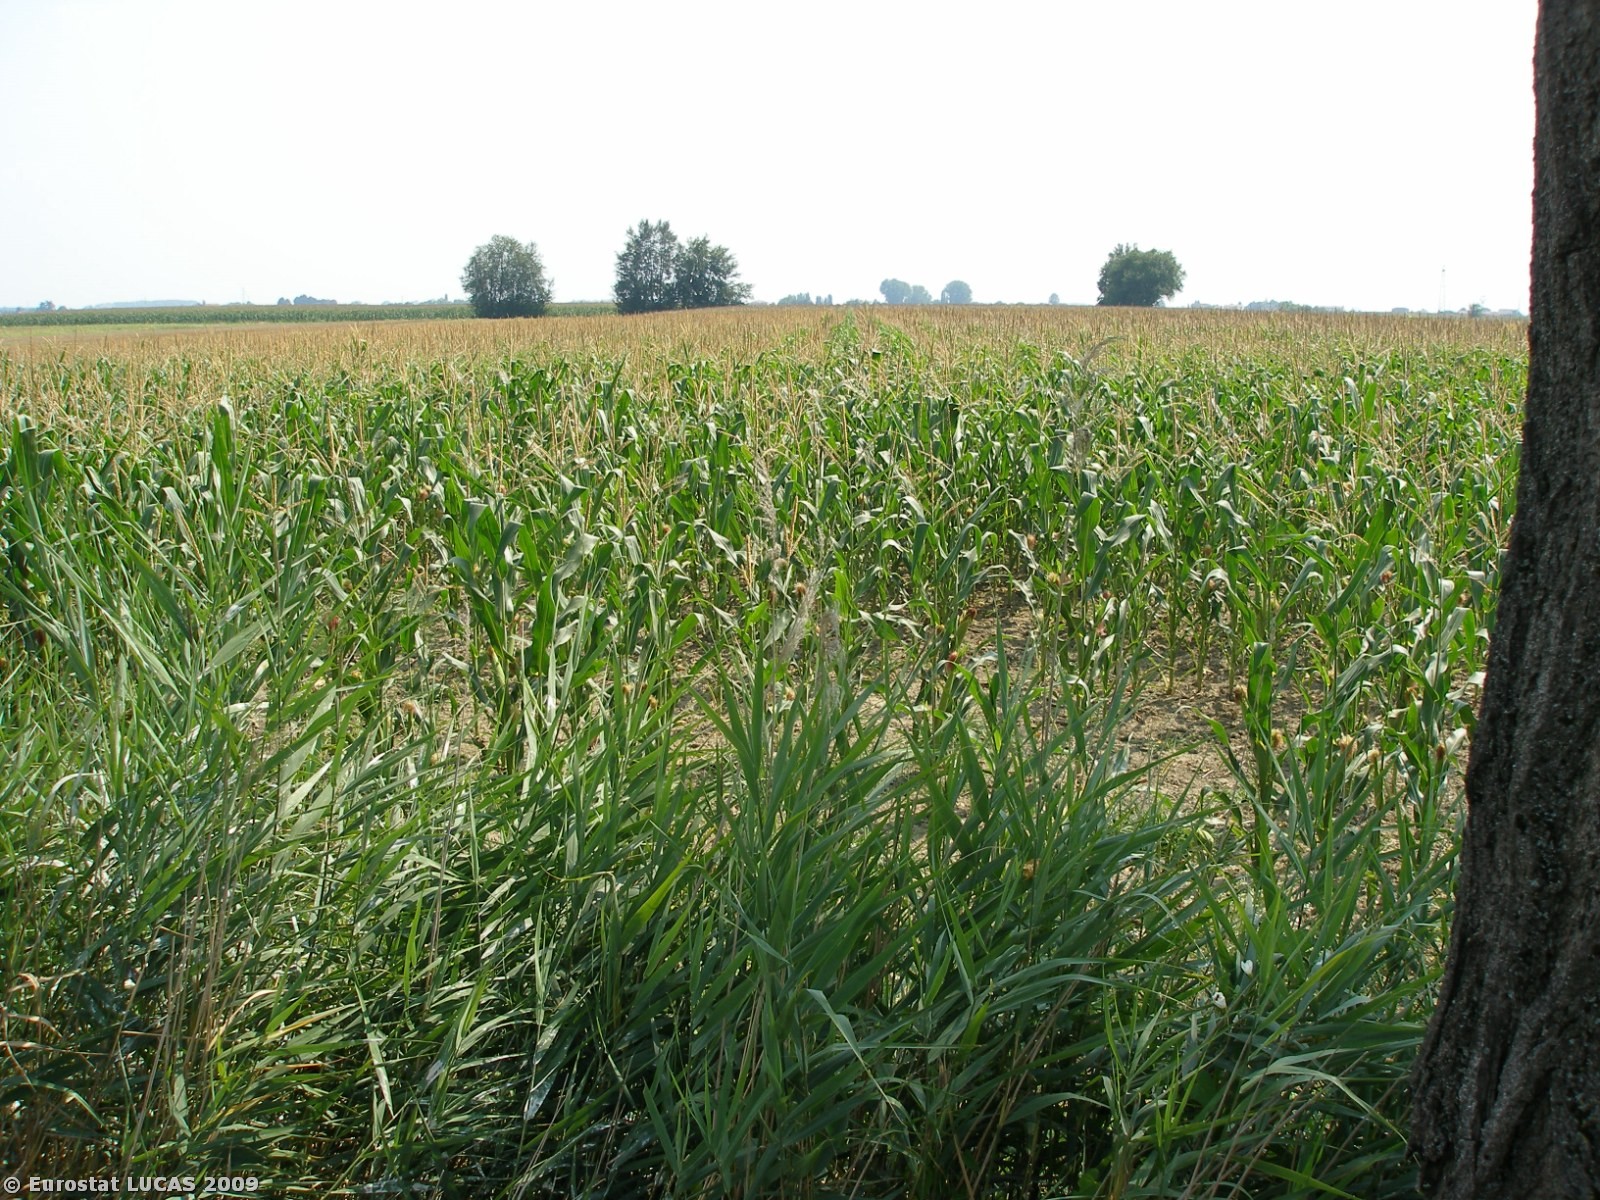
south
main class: Cropland
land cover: Maize
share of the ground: > 75 %
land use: Agriculture (excluding fallow land and kitchen gardens)
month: July
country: IT
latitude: 44.9505
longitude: 11.6573
